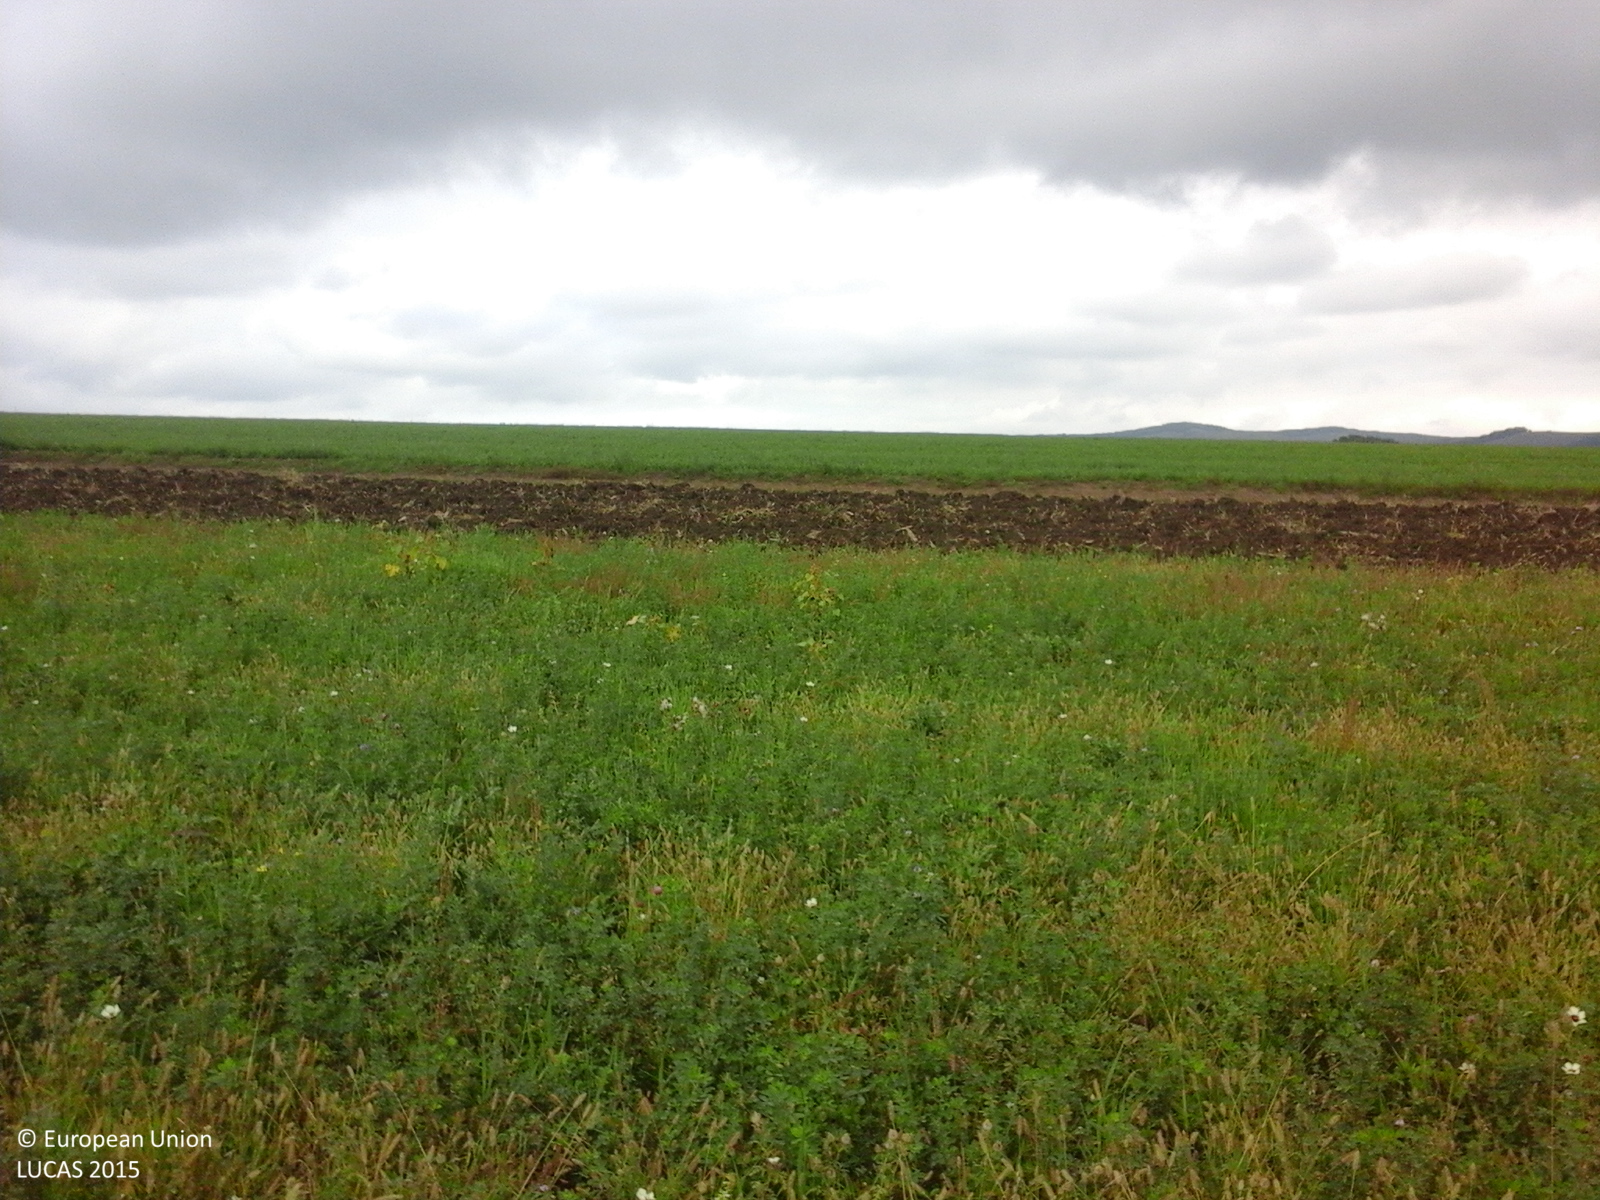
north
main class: Cropland
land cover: Maize
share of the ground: > 75 %
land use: Agriculture (excluding fallow land and kitchen gardens)
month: October
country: RO
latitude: 46.2555
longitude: 24.0737
